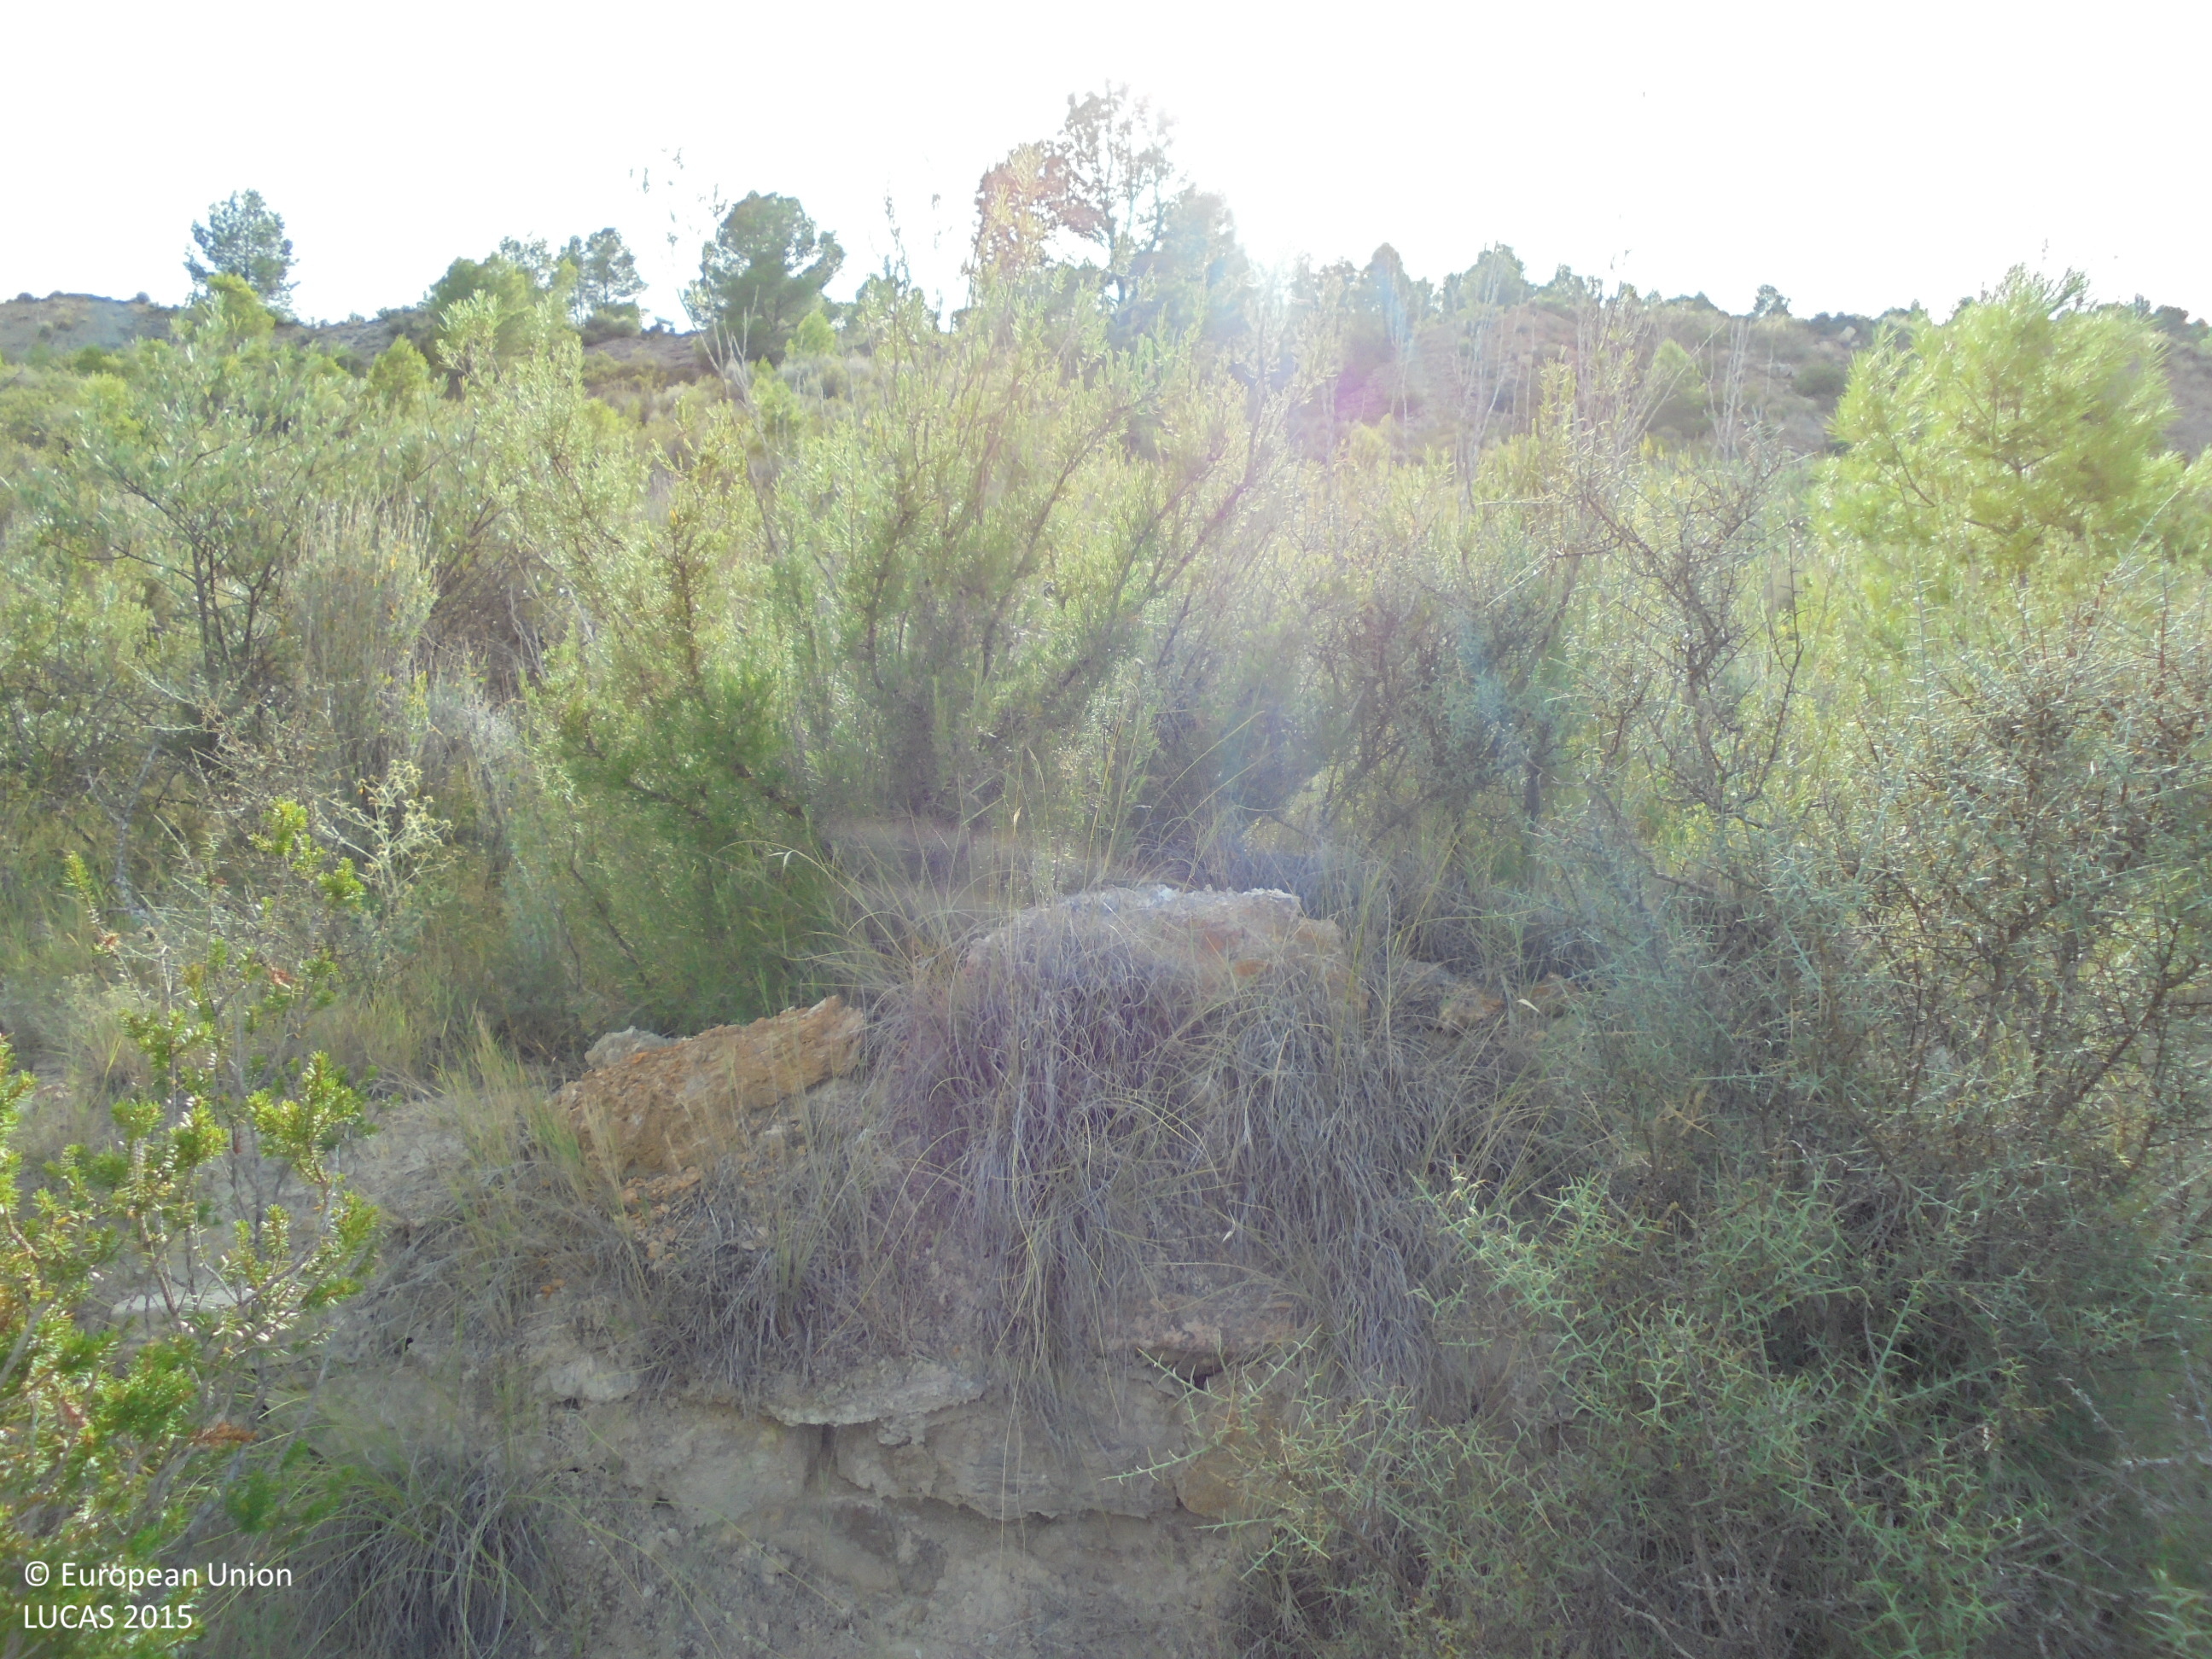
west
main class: Shrubland
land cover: Shrubland with sparse tree cover
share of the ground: > 75 %
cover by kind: shrubs 80 %, unconsolidated bare surface 15 %, coniferous forest trees 5 %
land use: Abandoned areas
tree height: > 5 m
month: August
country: ES
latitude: 39.1639
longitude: -1.0732
